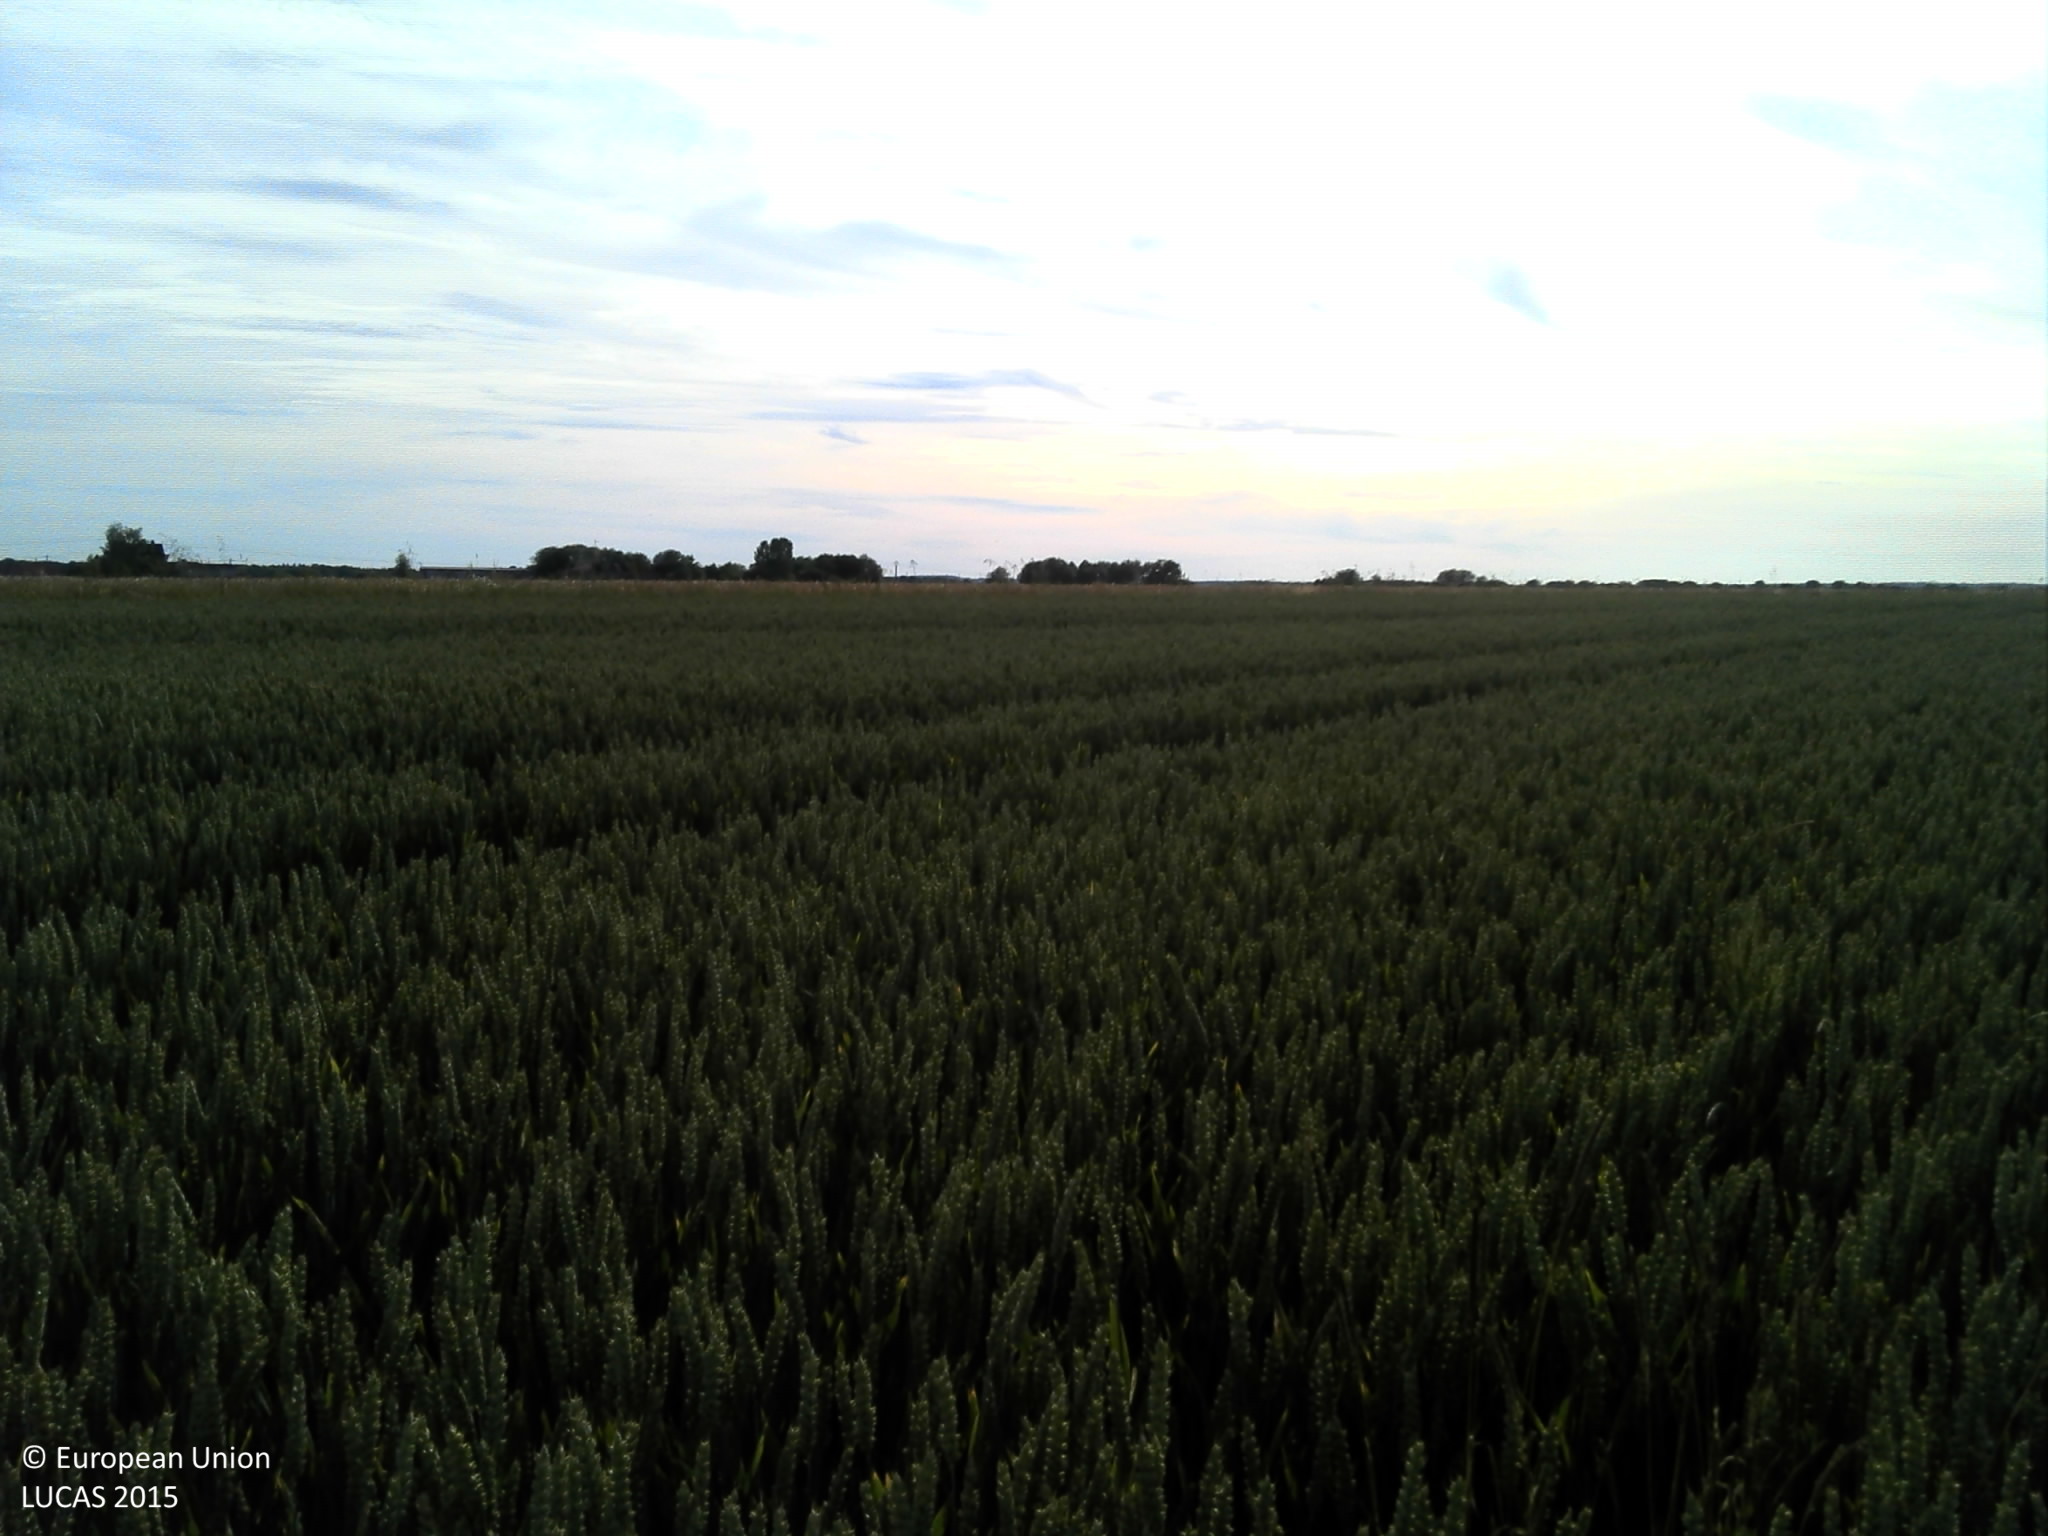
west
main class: Cropland
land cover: Common wheat
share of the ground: > 75 %
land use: Agriculture (excluding fallow land and kitchen gardens)
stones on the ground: < 10 %
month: June
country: FR
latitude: 49.3954
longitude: 6.0450
